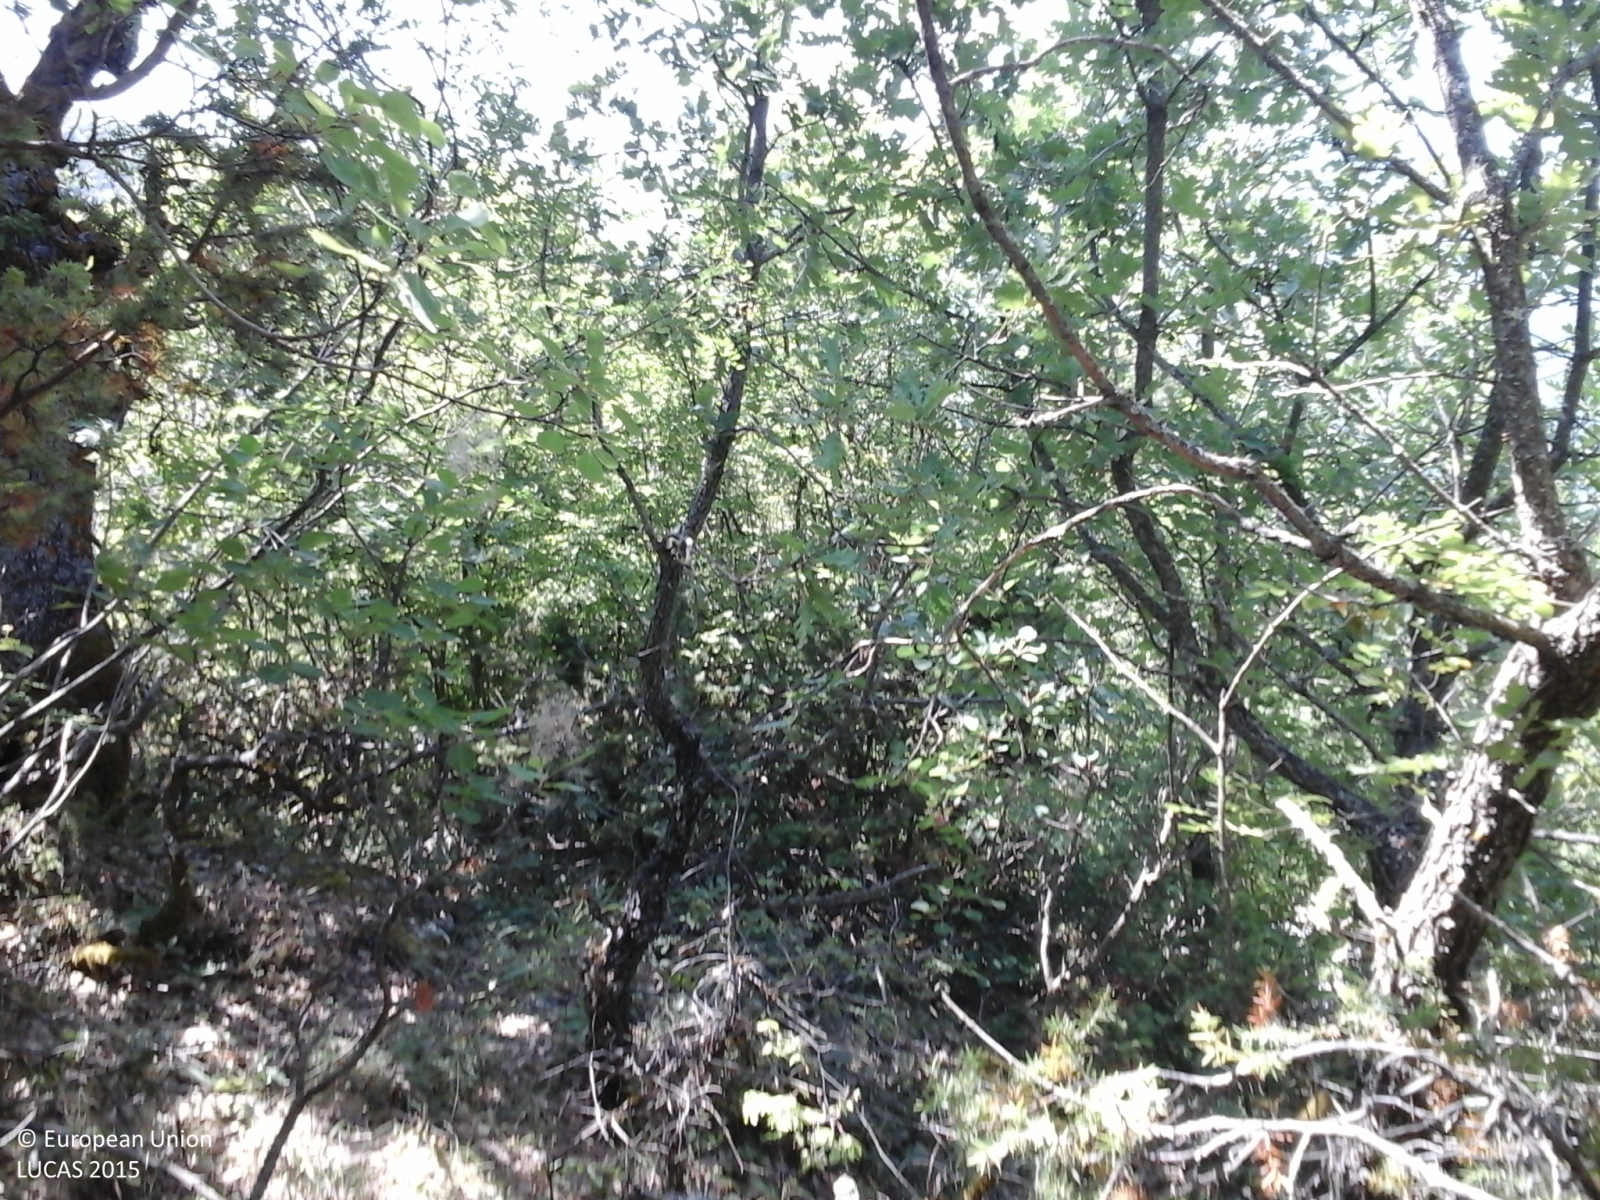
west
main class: Woodland
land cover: Broadleaved woodland
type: thermophilous deciduous forest
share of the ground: > 75 %
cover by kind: broadleaved forest trees 85 %, herbaceous plants 10 %, shrubs 5 %
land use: Forestry
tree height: > 5 m
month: July
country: GR
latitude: 40.0956
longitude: 20.7383
